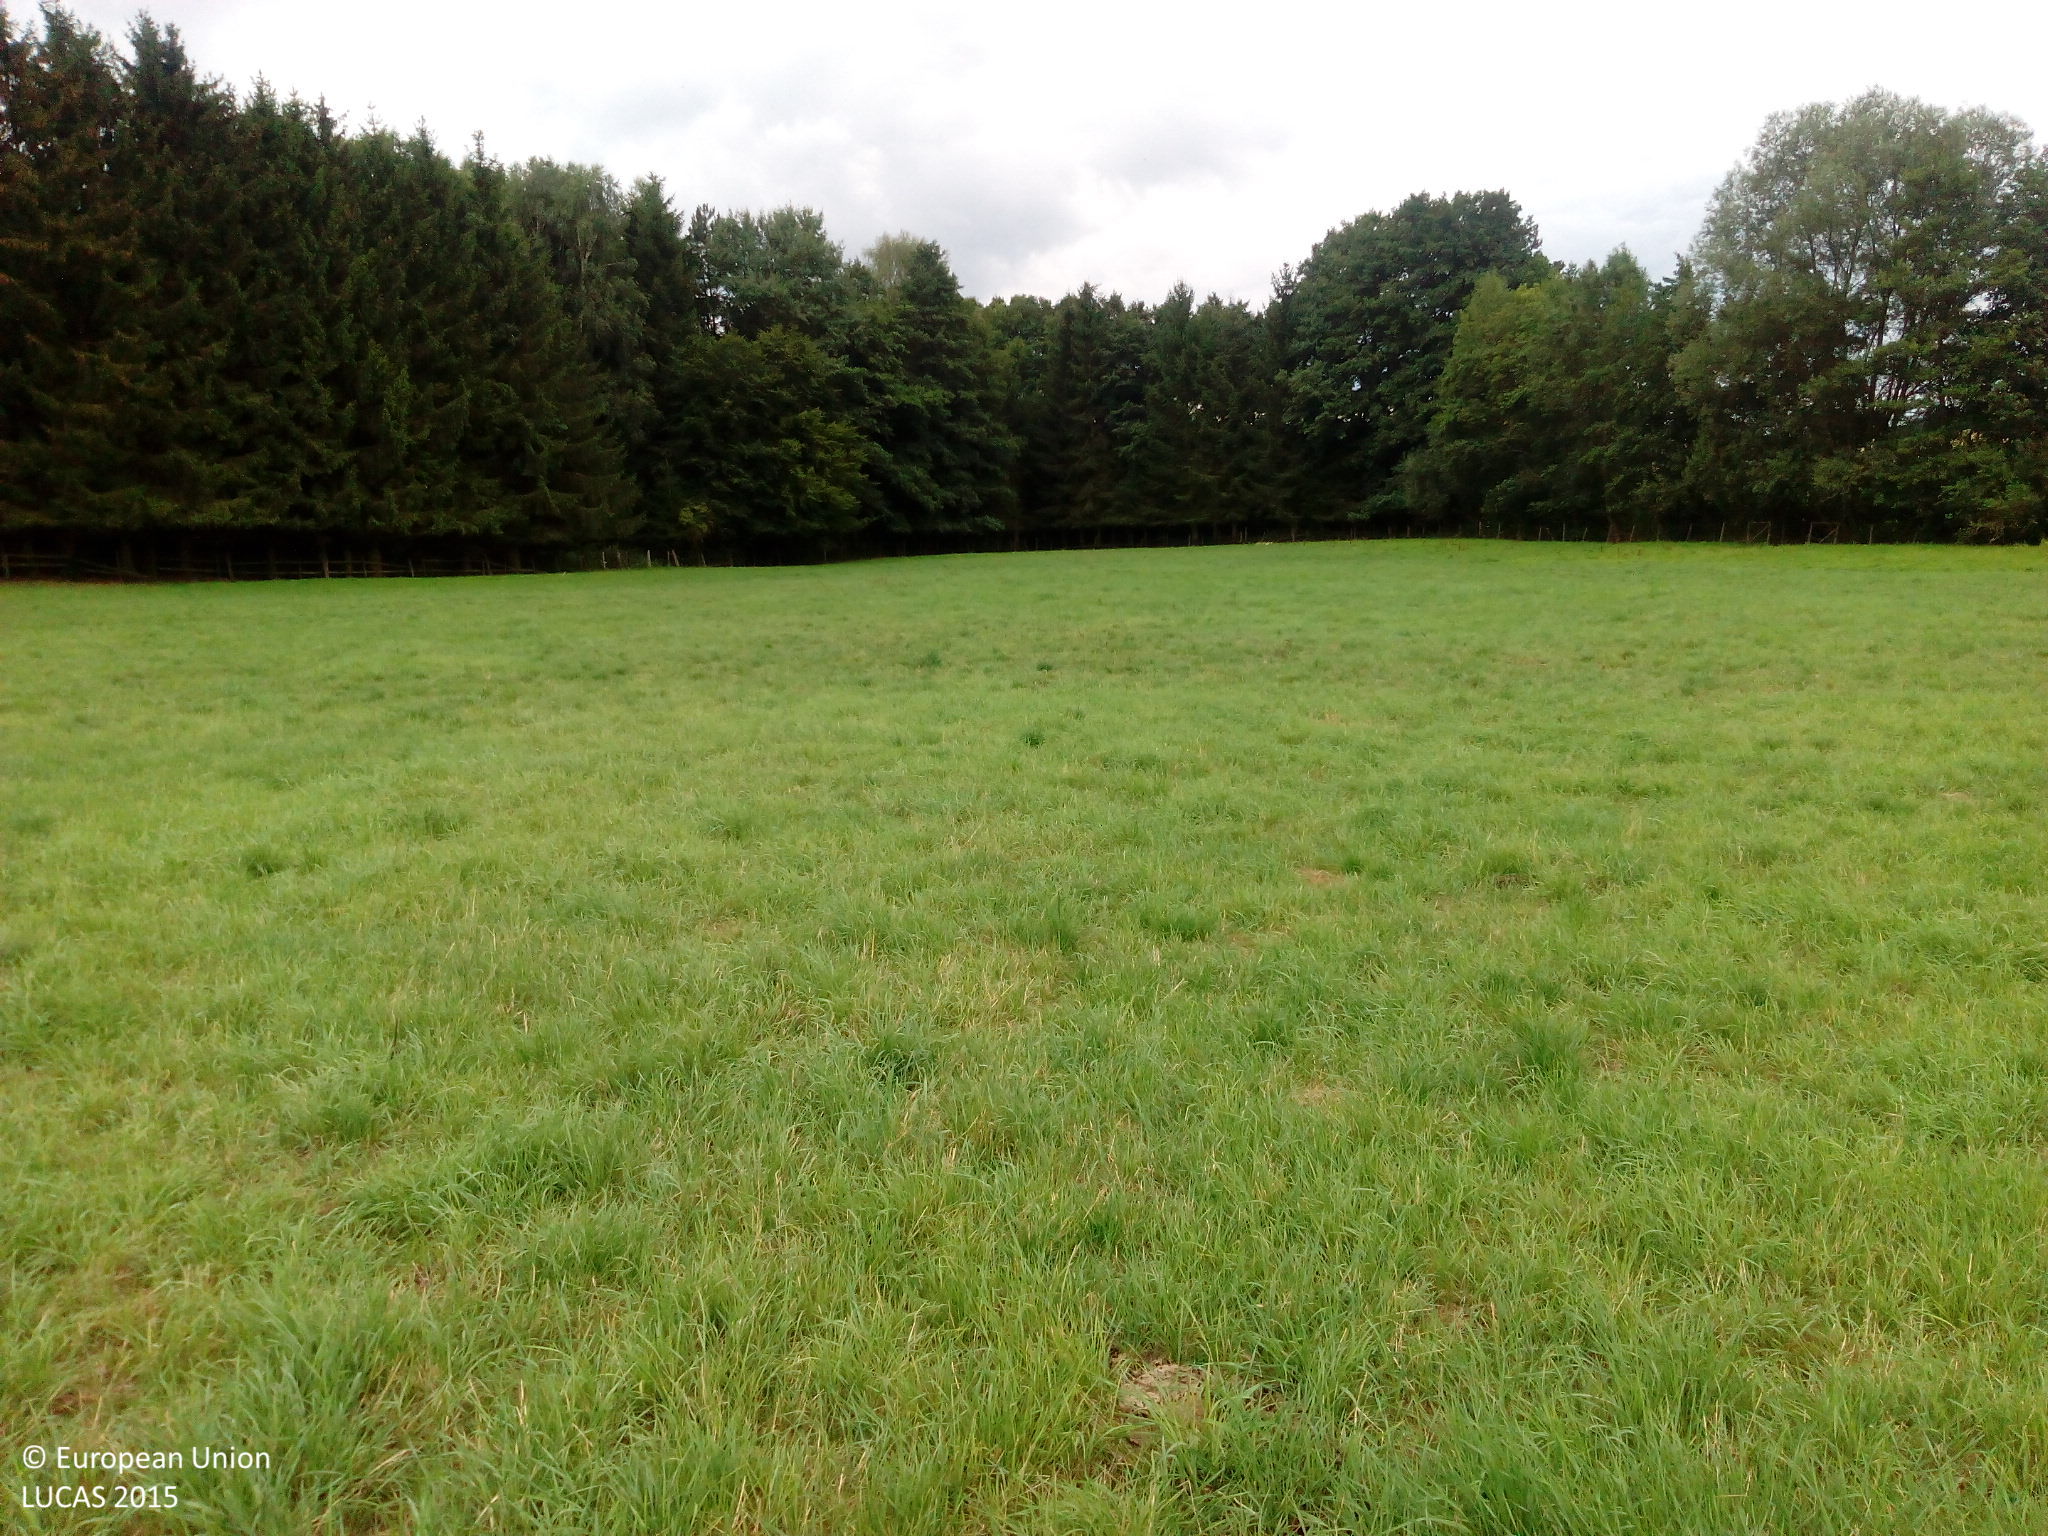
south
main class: Grassland
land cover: Grassland without tree/shrub cover
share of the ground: > 75 %
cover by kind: herbaceous plants 95 %, unconsolidated bare surface 5 %
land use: Agriculture (excluding fallow land and kitchen gardens)
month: August
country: DE
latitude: 50.0489
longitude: 7.5005
